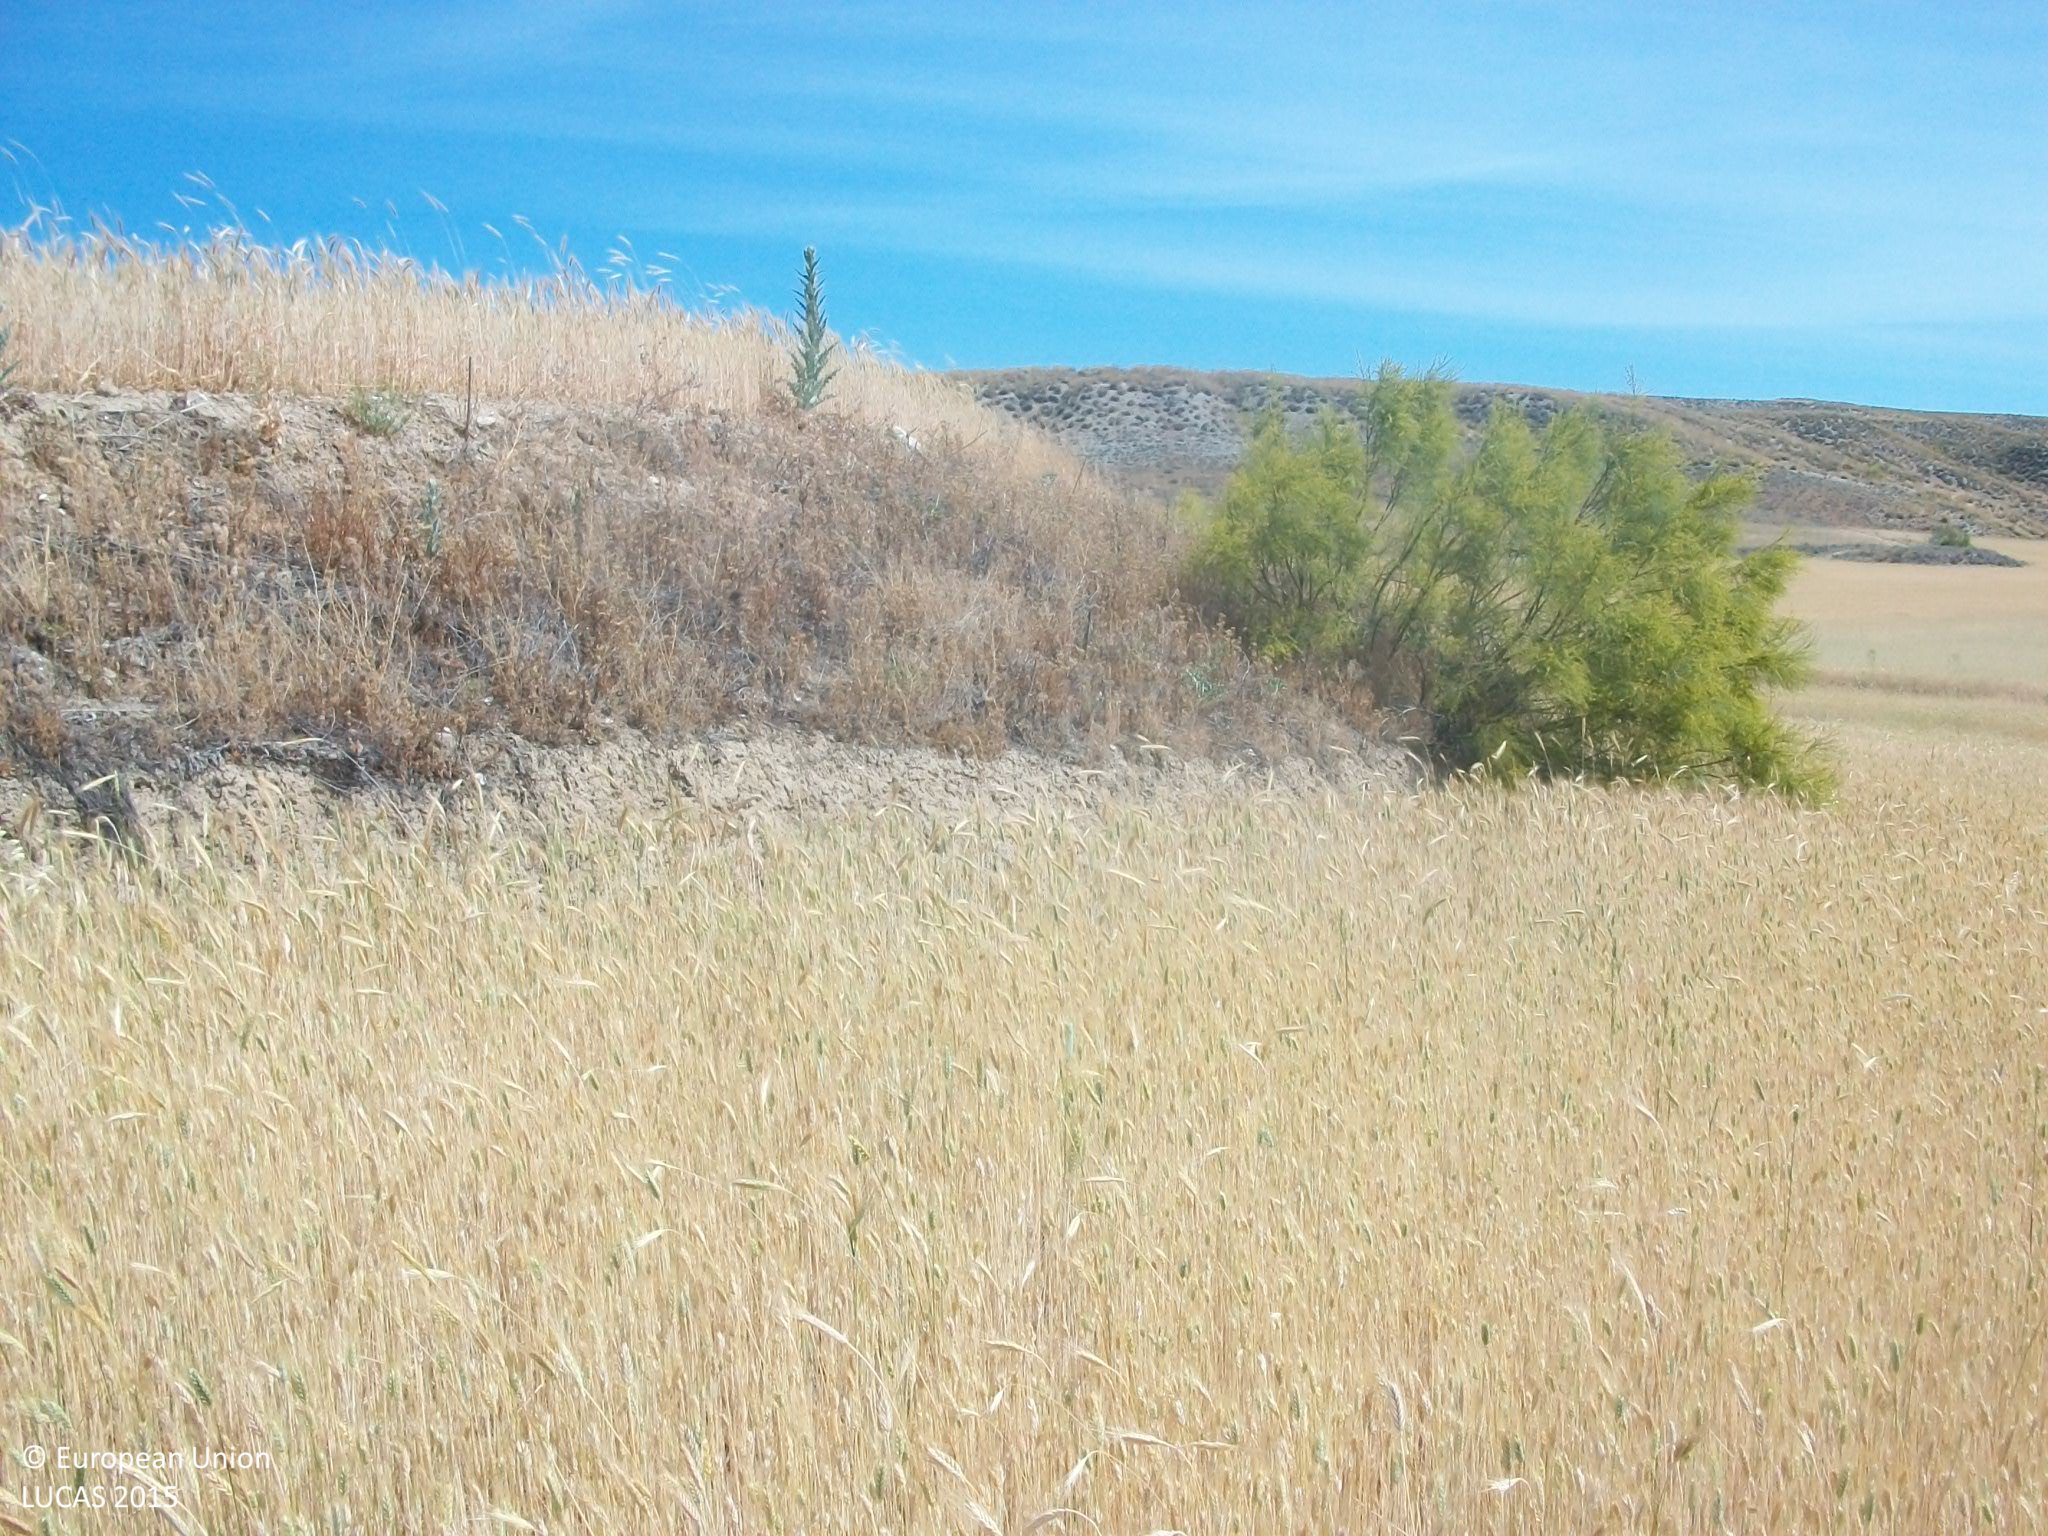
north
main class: Cropland
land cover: Common wheat
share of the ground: > 75 %
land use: Agriculture (excluding fallow land and kitchen gardens)
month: May
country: ES
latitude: 40.0539
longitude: -3.6893
